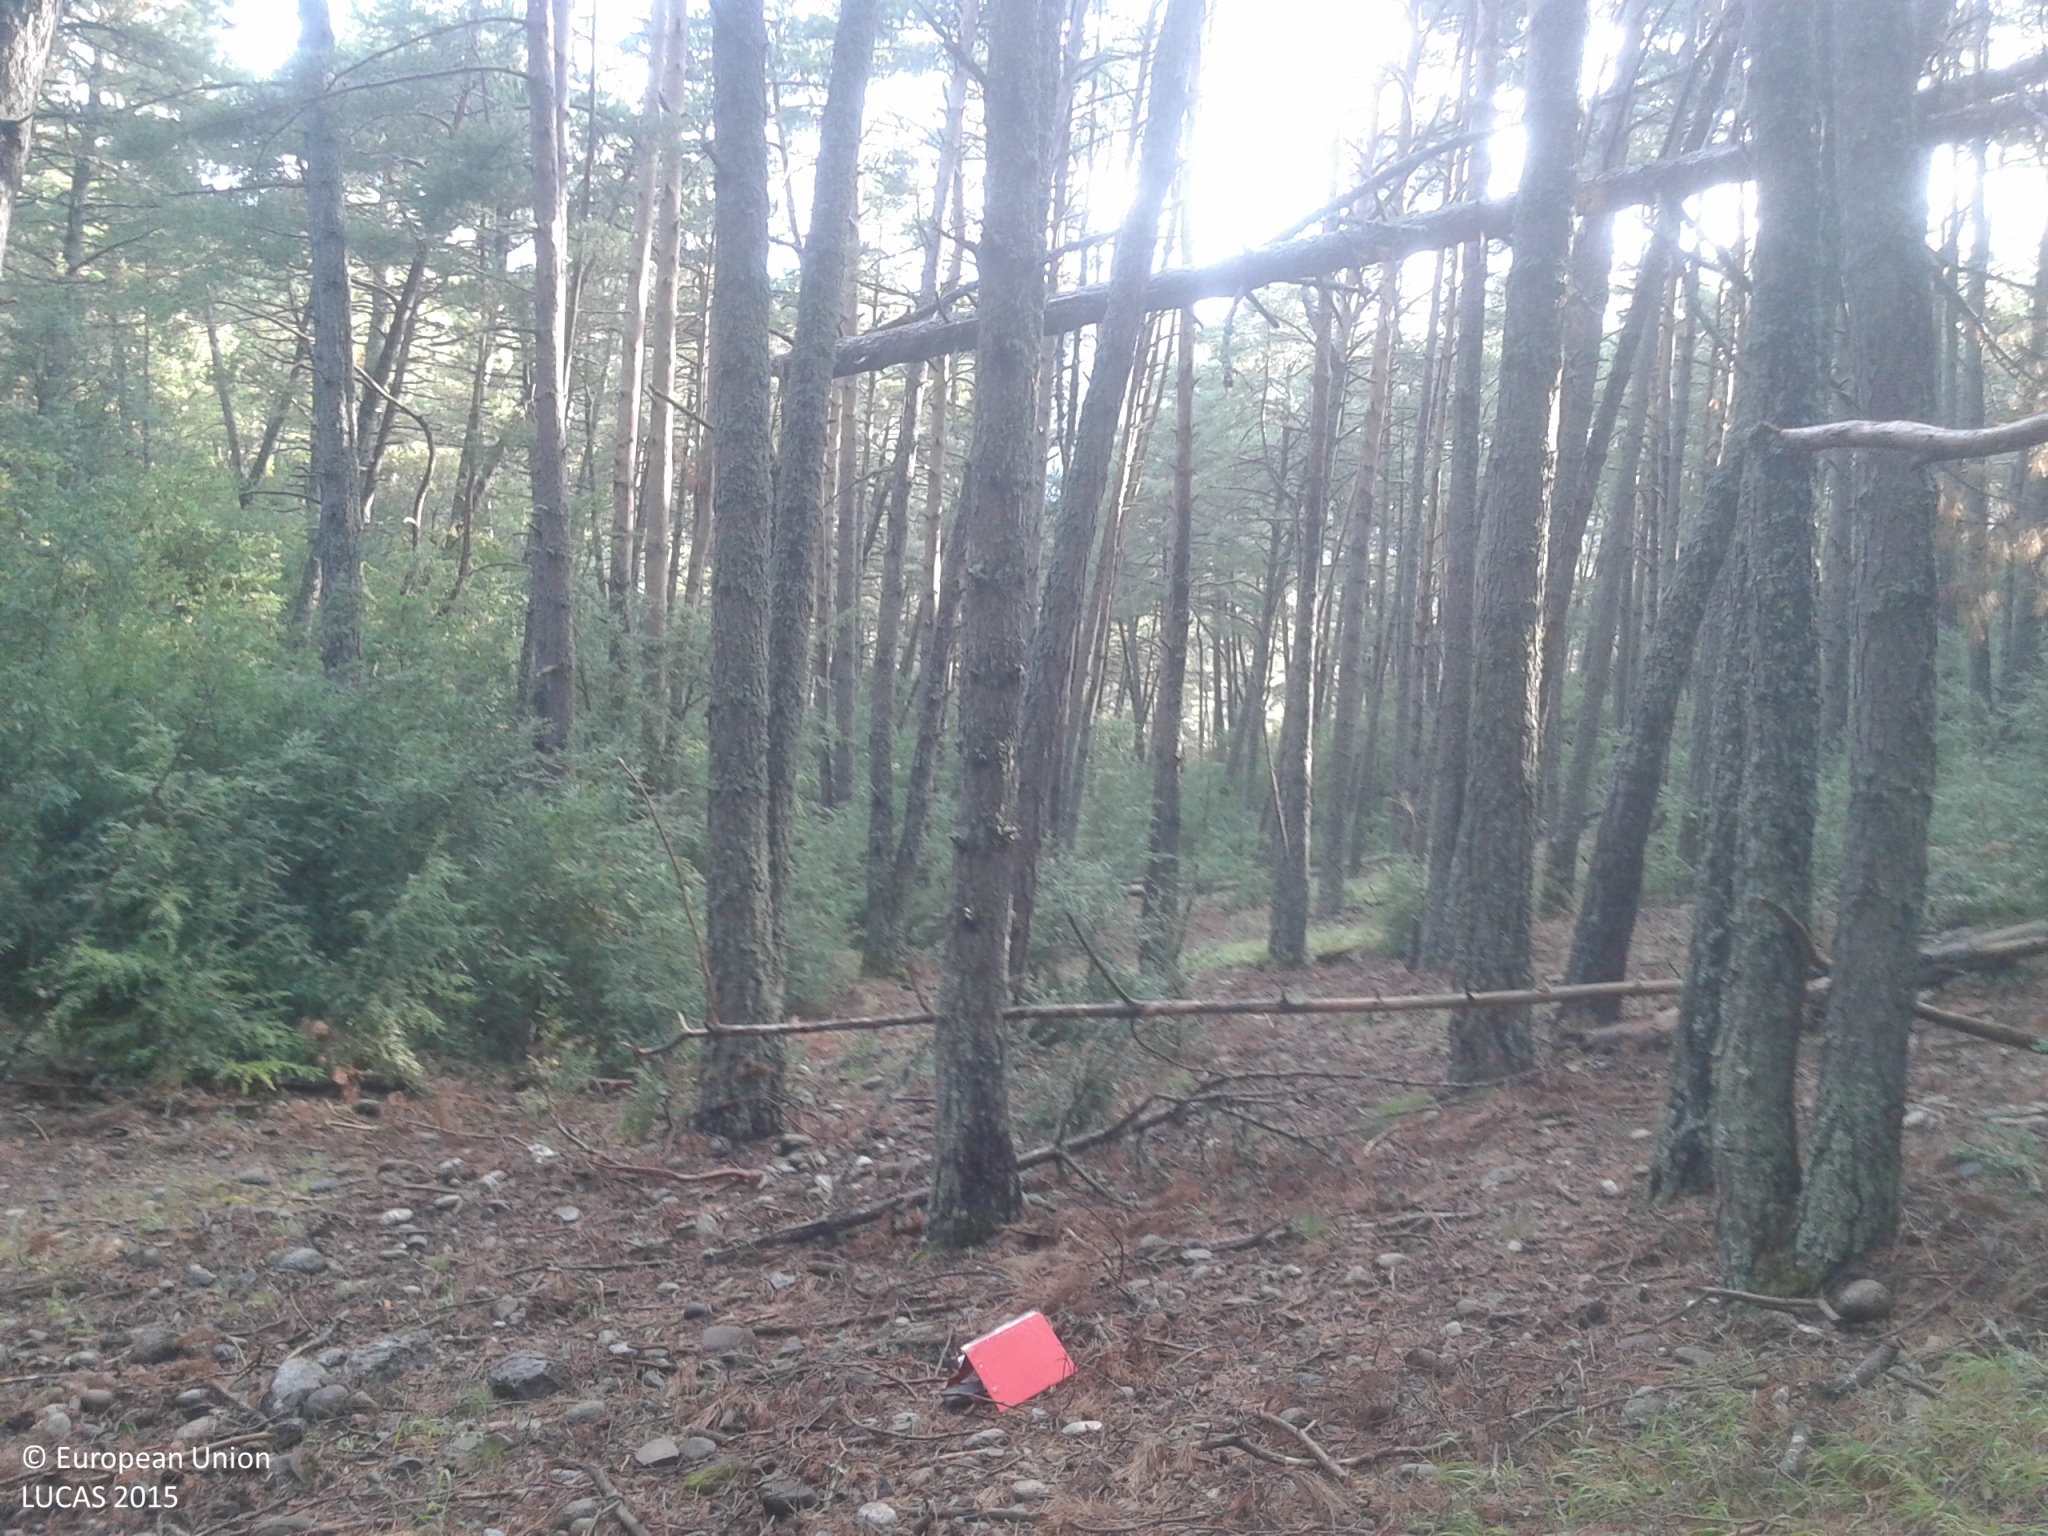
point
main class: Woodland
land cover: Pine dominated coniferous woodland
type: coniferous forest of the mediterranean region
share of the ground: > 75 %
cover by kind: coniferous forest trees 90 %, shrubs 5 %, herbaceous plants 5 %
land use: Forestry
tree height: > 5 m
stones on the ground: > 50 %
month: August
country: ES
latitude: 42.2594
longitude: 1.0751
